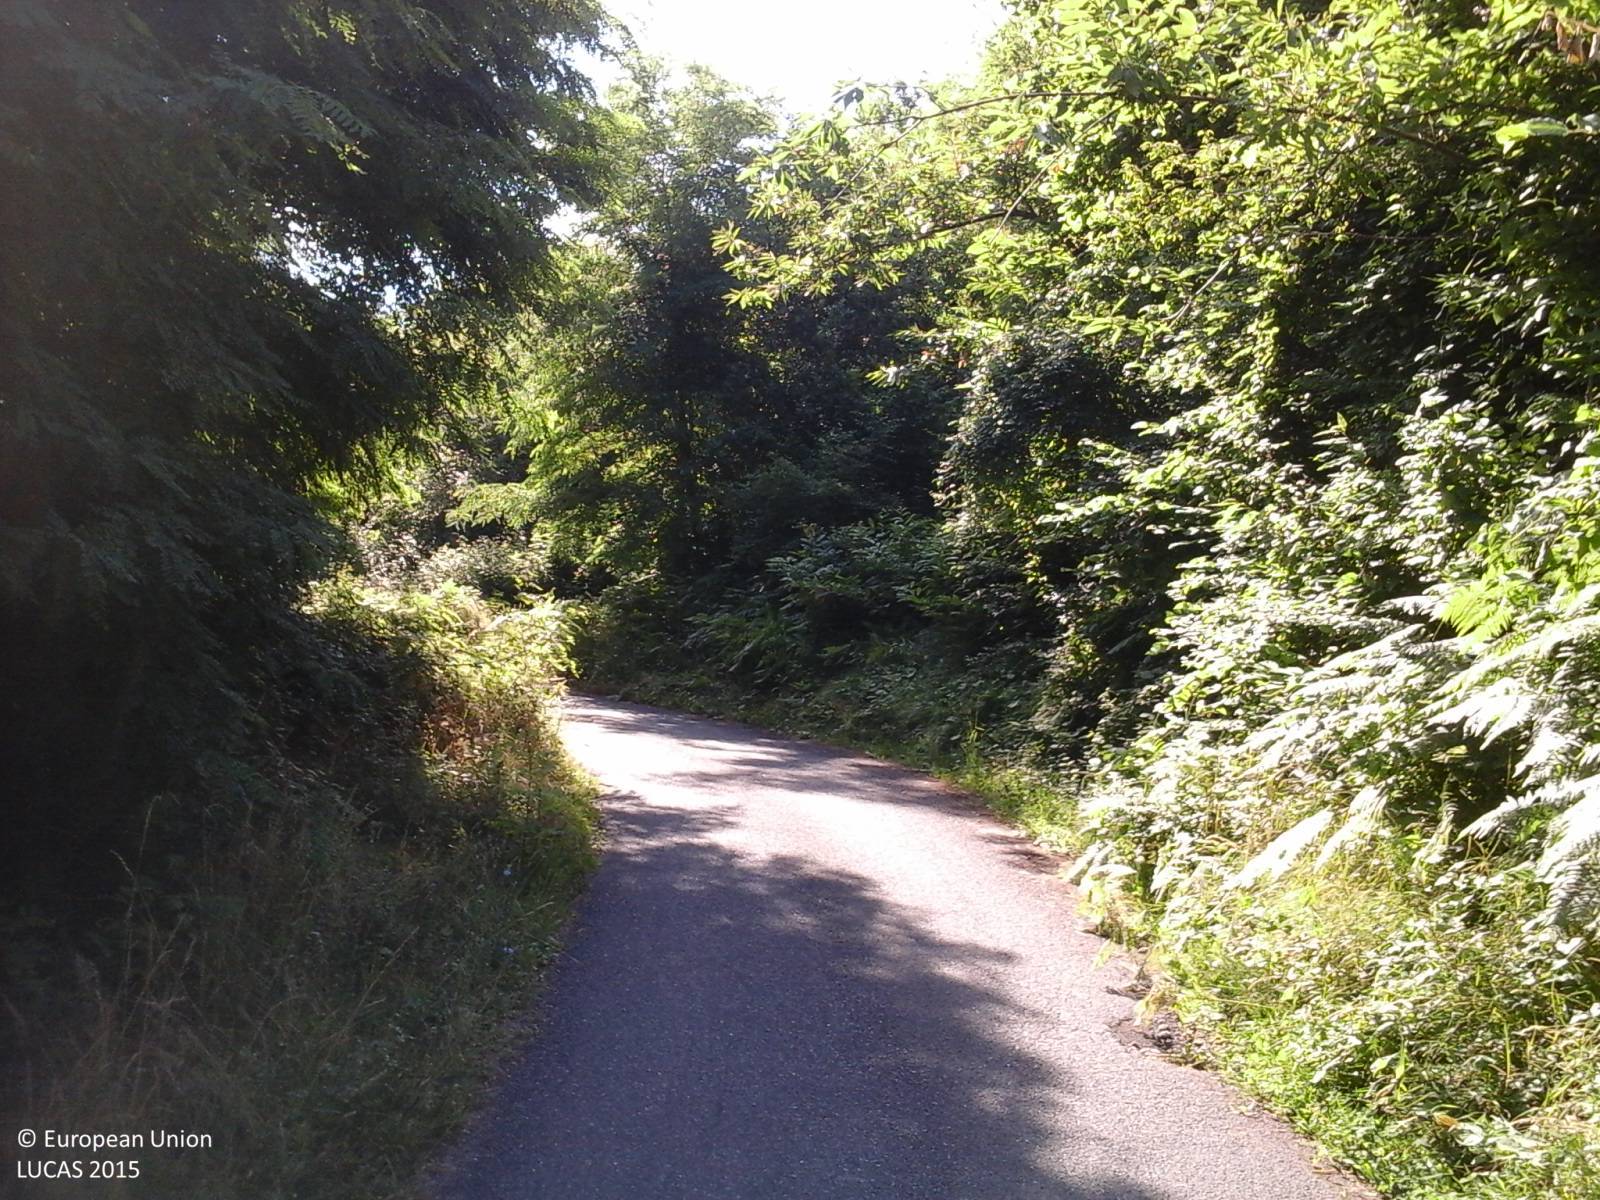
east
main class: Woodland
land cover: Broadleaved woodland
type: thermophilous deciduous forest
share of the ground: > 75 %
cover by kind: broadleaved forest trees 50 %, shrubs 50 %
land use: Forestry
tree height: > 5 m
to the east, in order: Broadleaved woodland; Paved roads, cycling and walking lanes; Broadleaved woodland
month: June
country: IT
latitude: 44.3505
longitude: 9.8874
